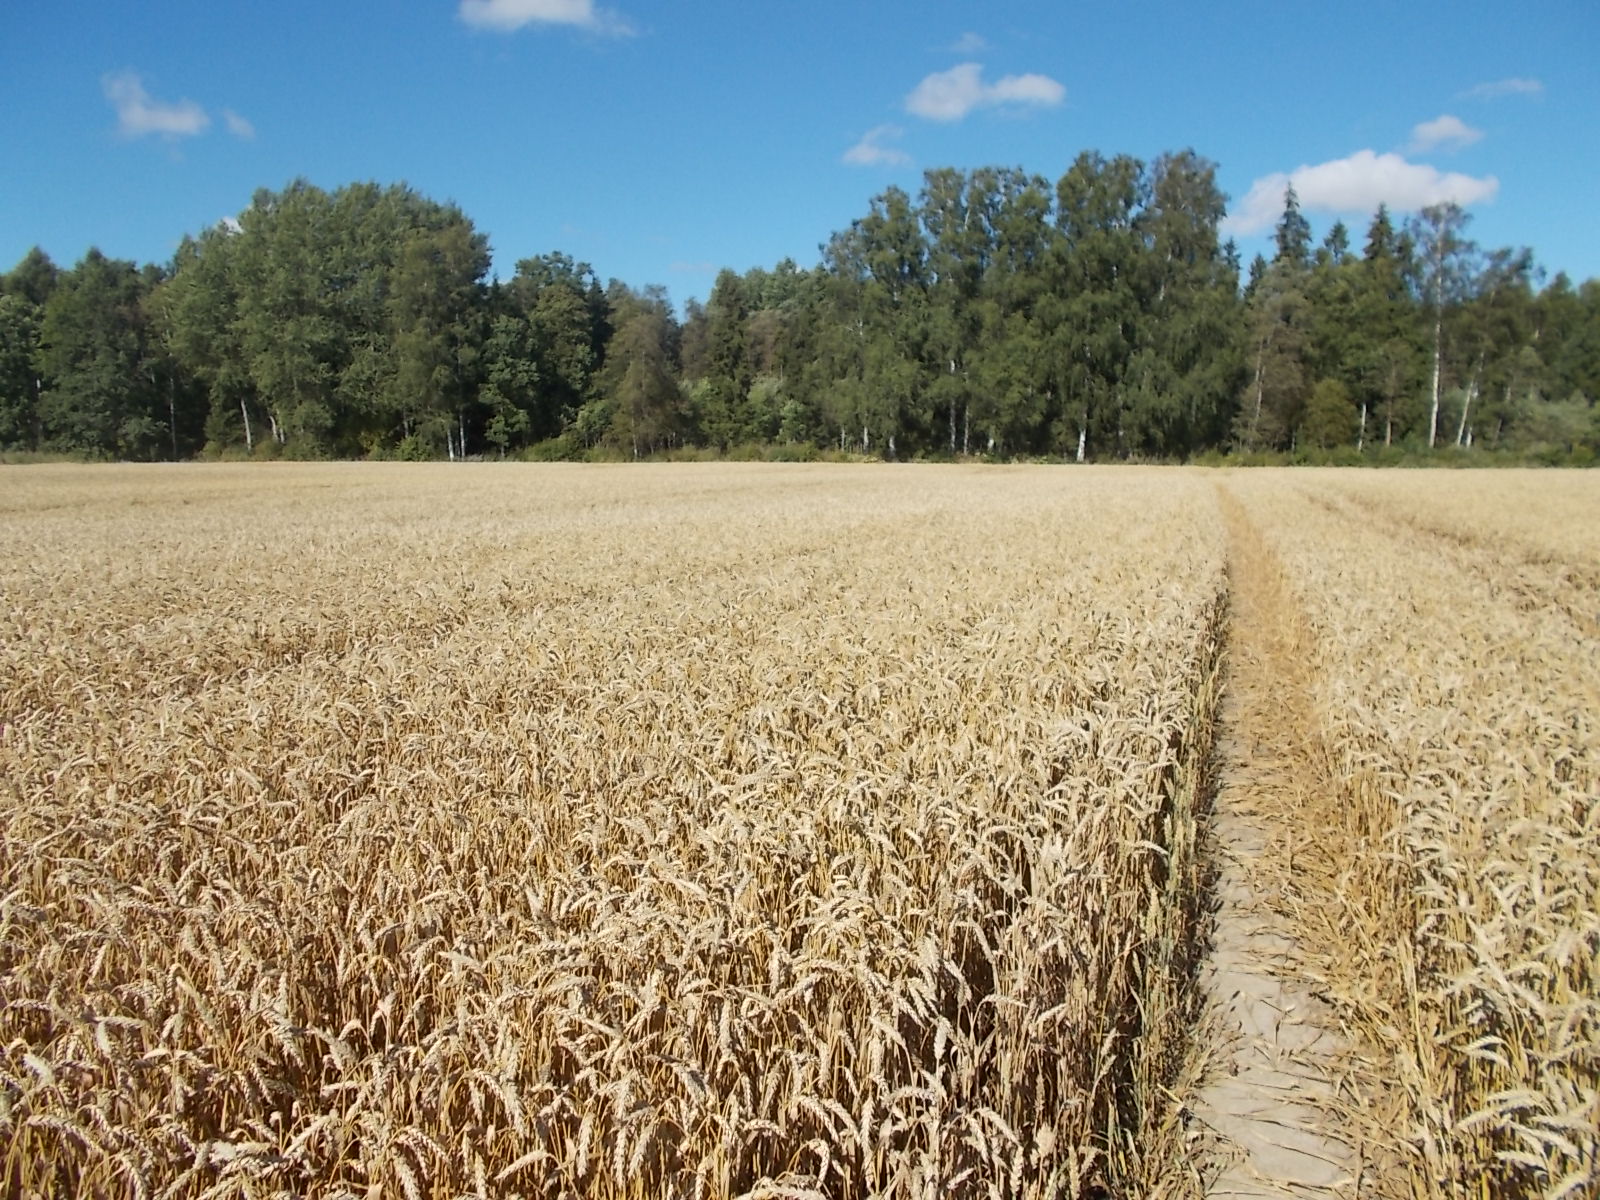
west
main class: Cropland
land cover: Common wheat
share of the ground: > 75 %
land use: Agriculture (excluding fallow land and kitchen gardens)
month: August
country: LV
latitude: 56.8992
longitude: 22.9181
